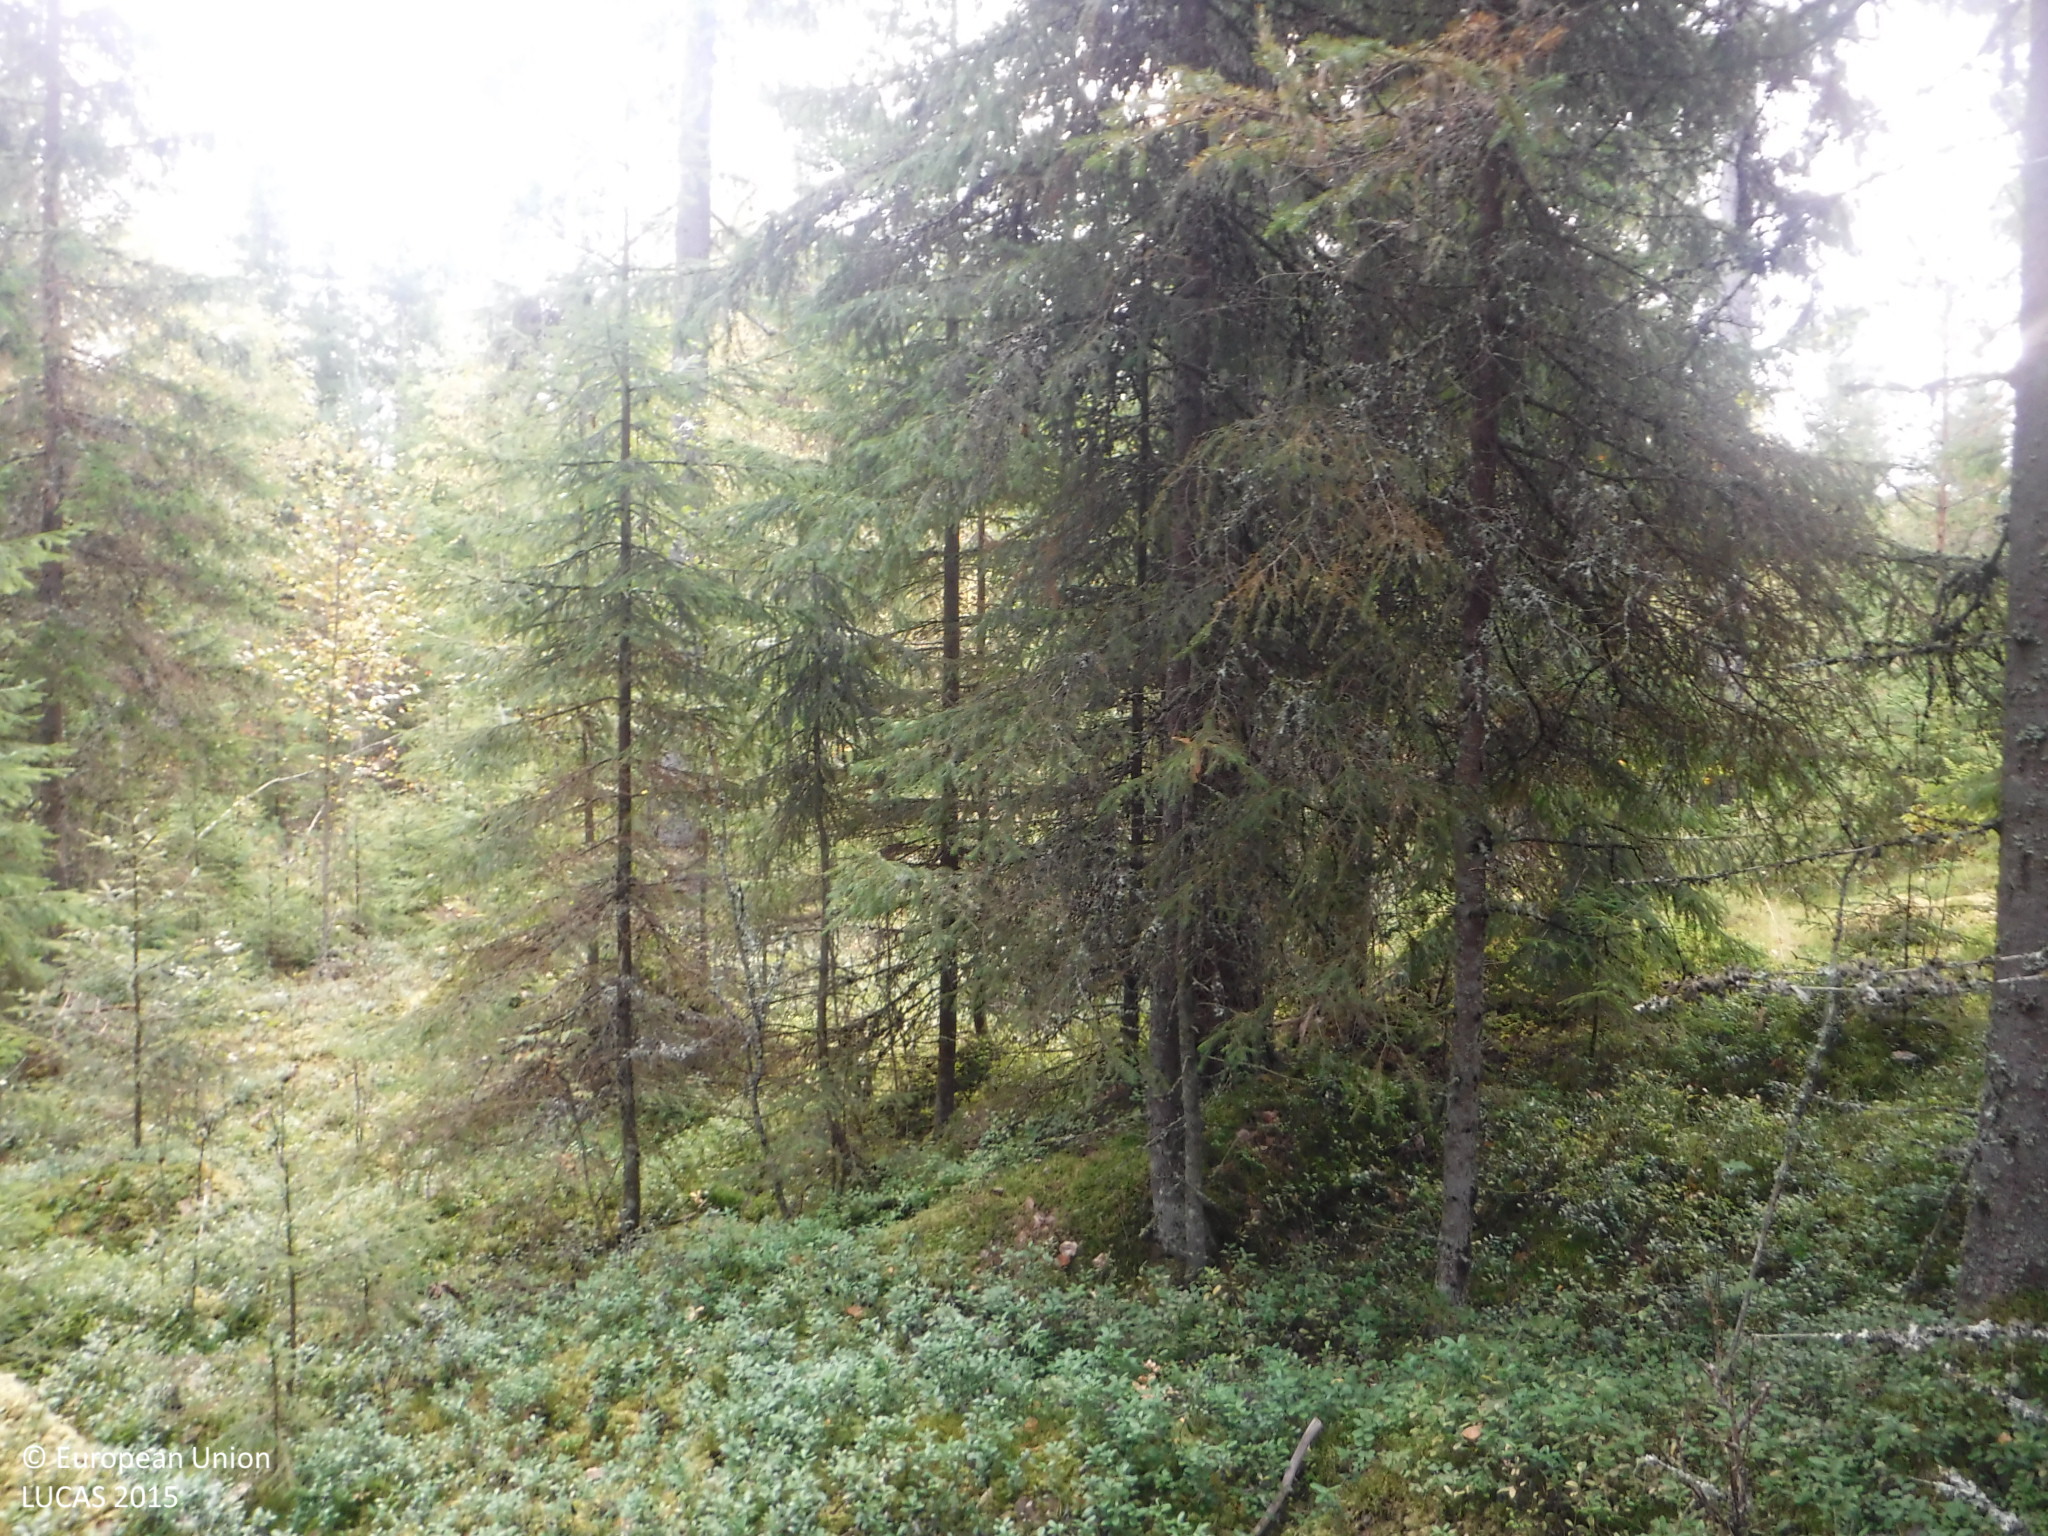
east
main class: Woodland
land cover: Spruce dominated mixed woodland
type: boreal forest
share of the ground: 50 - 75 %
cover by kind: coniferous forest trees 35 %, shrubs 25 %, lichens and mosses 25 %, broadleaved forest trees 15 %
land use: Forestry
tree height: > 5 m
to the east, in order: Spruce dominated mixed woodland; Pine dominated mixed woodland; Grass margins; Tracks; Grass margins; Ditches and canals; Shruby margins; Other mixed woodland
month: September
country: FI
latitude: 61.7343
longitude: 22.1527
